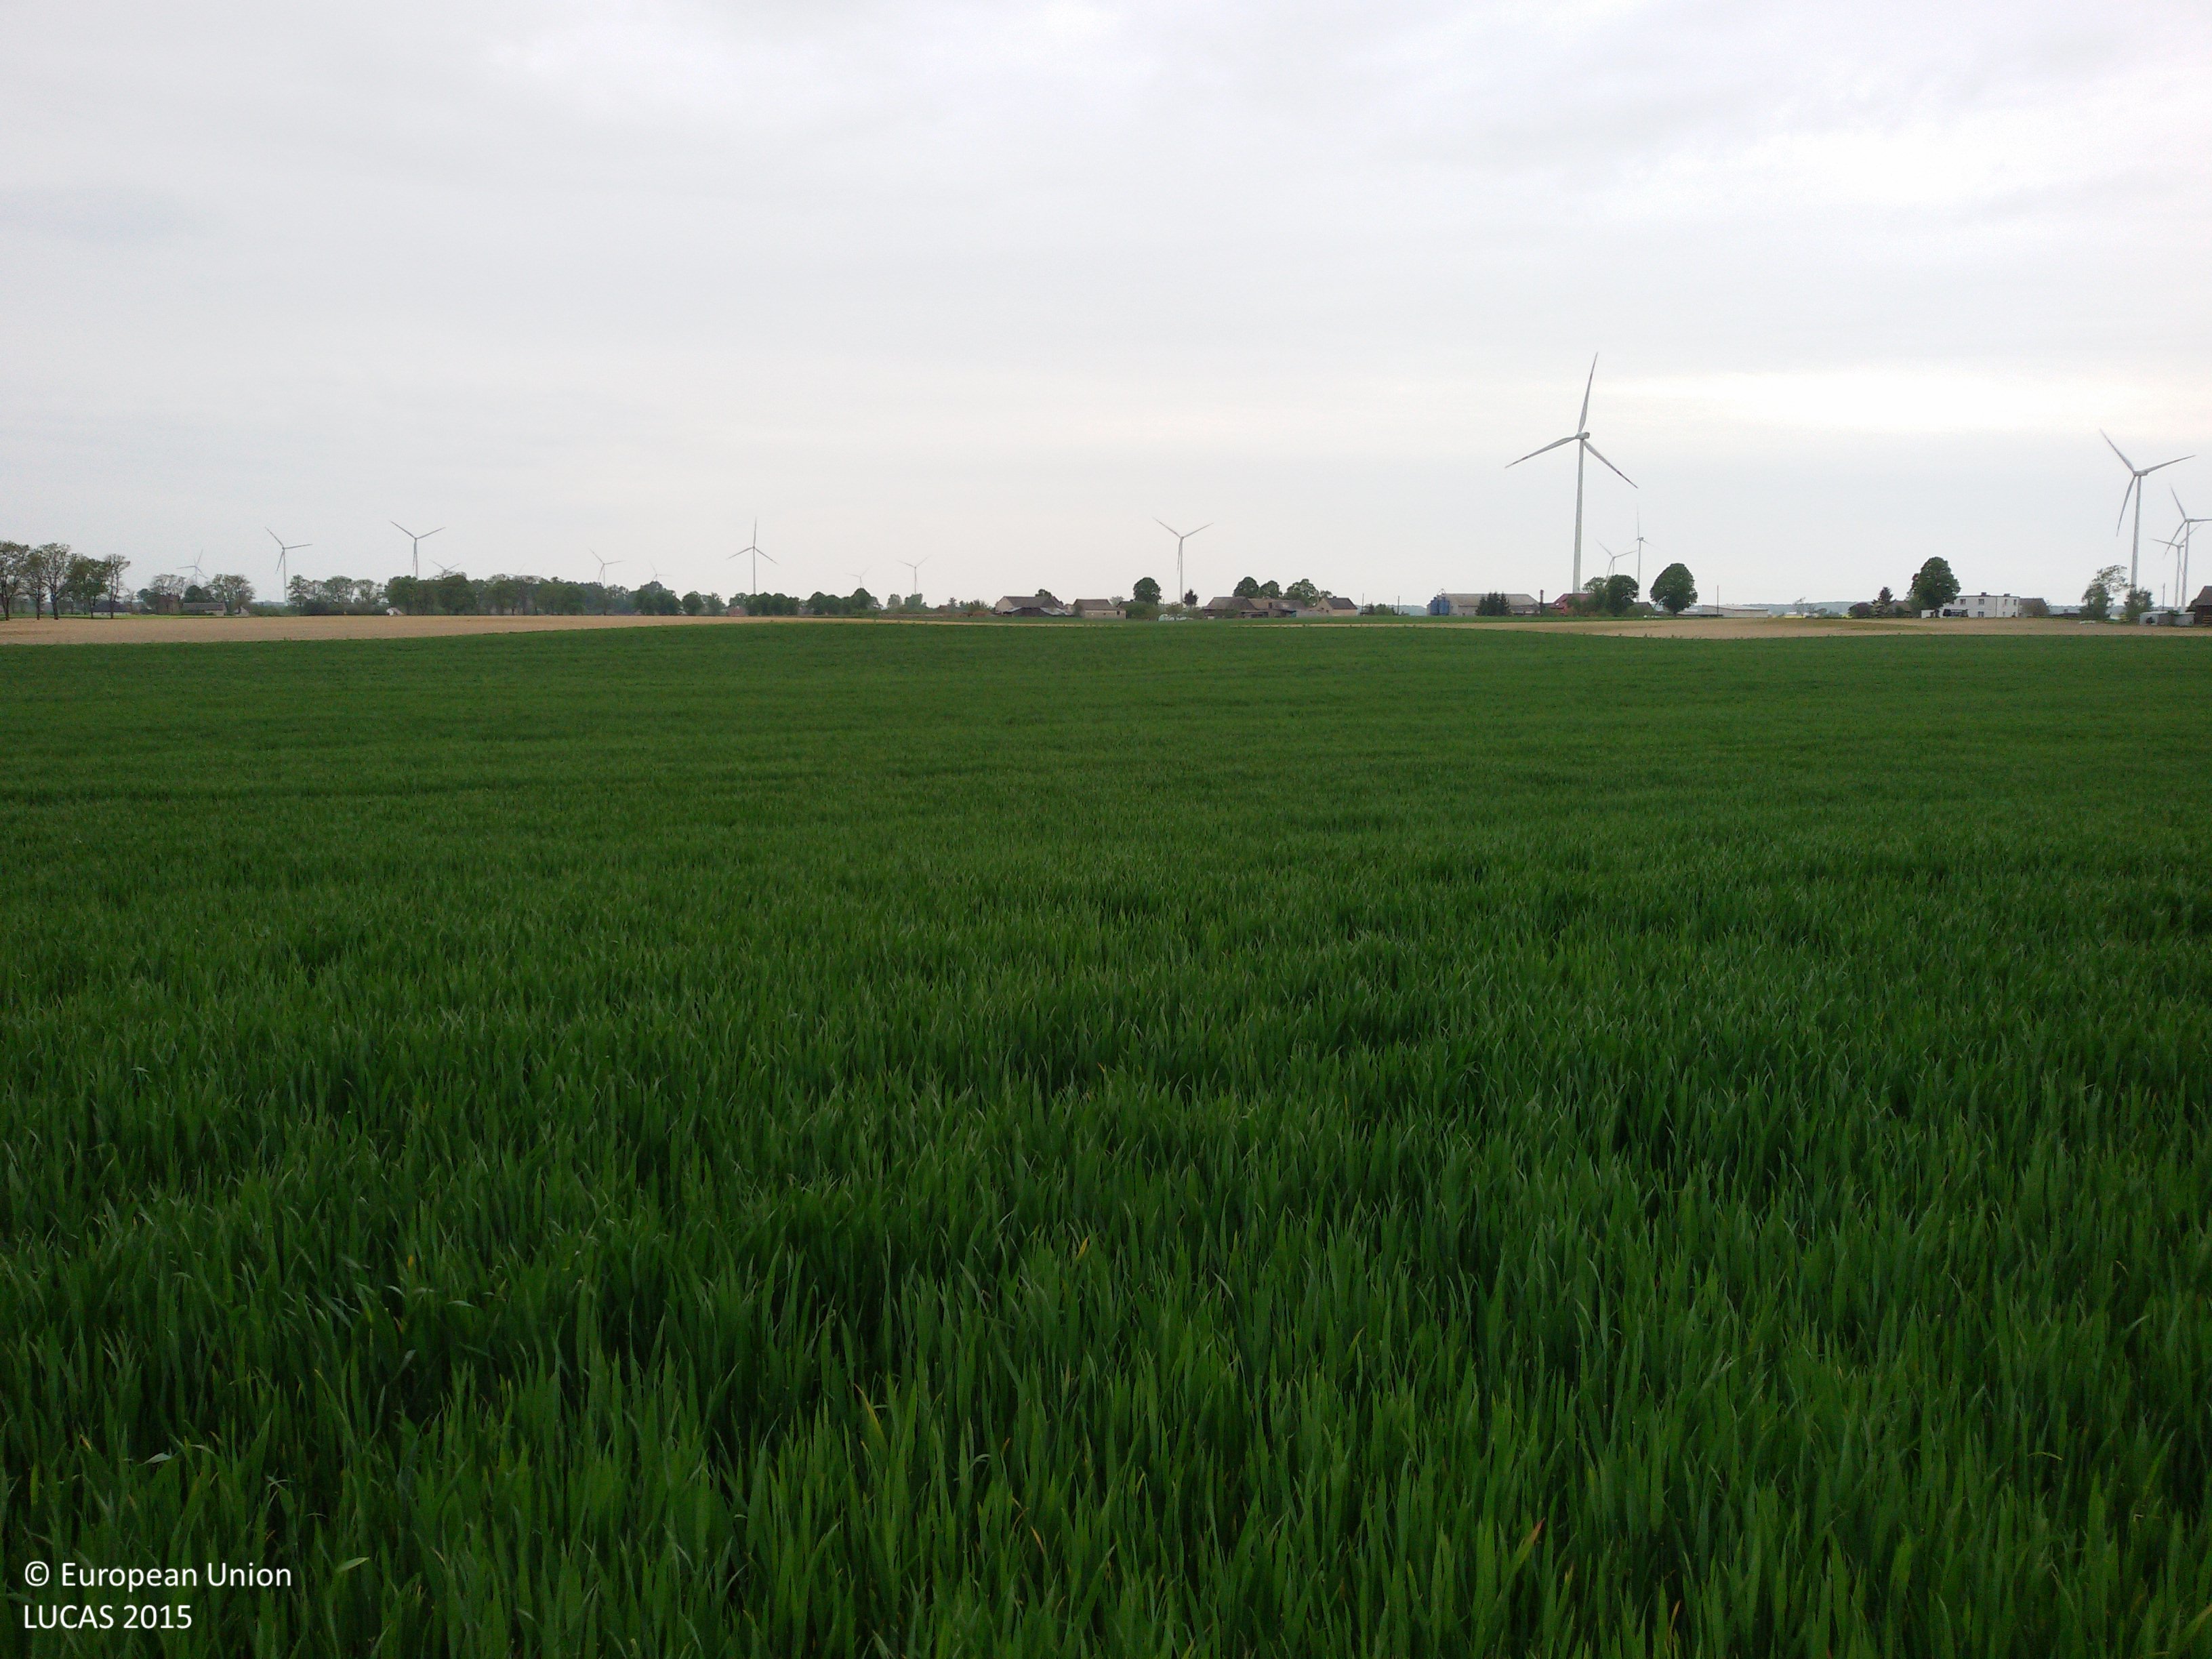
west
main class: Cropland
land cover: Common wheat
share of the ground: > 75 %
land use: Agriculture (excluding fallow land and kitchen gardens)
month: May
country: PL
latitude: 52.9708
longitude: 17.2026
